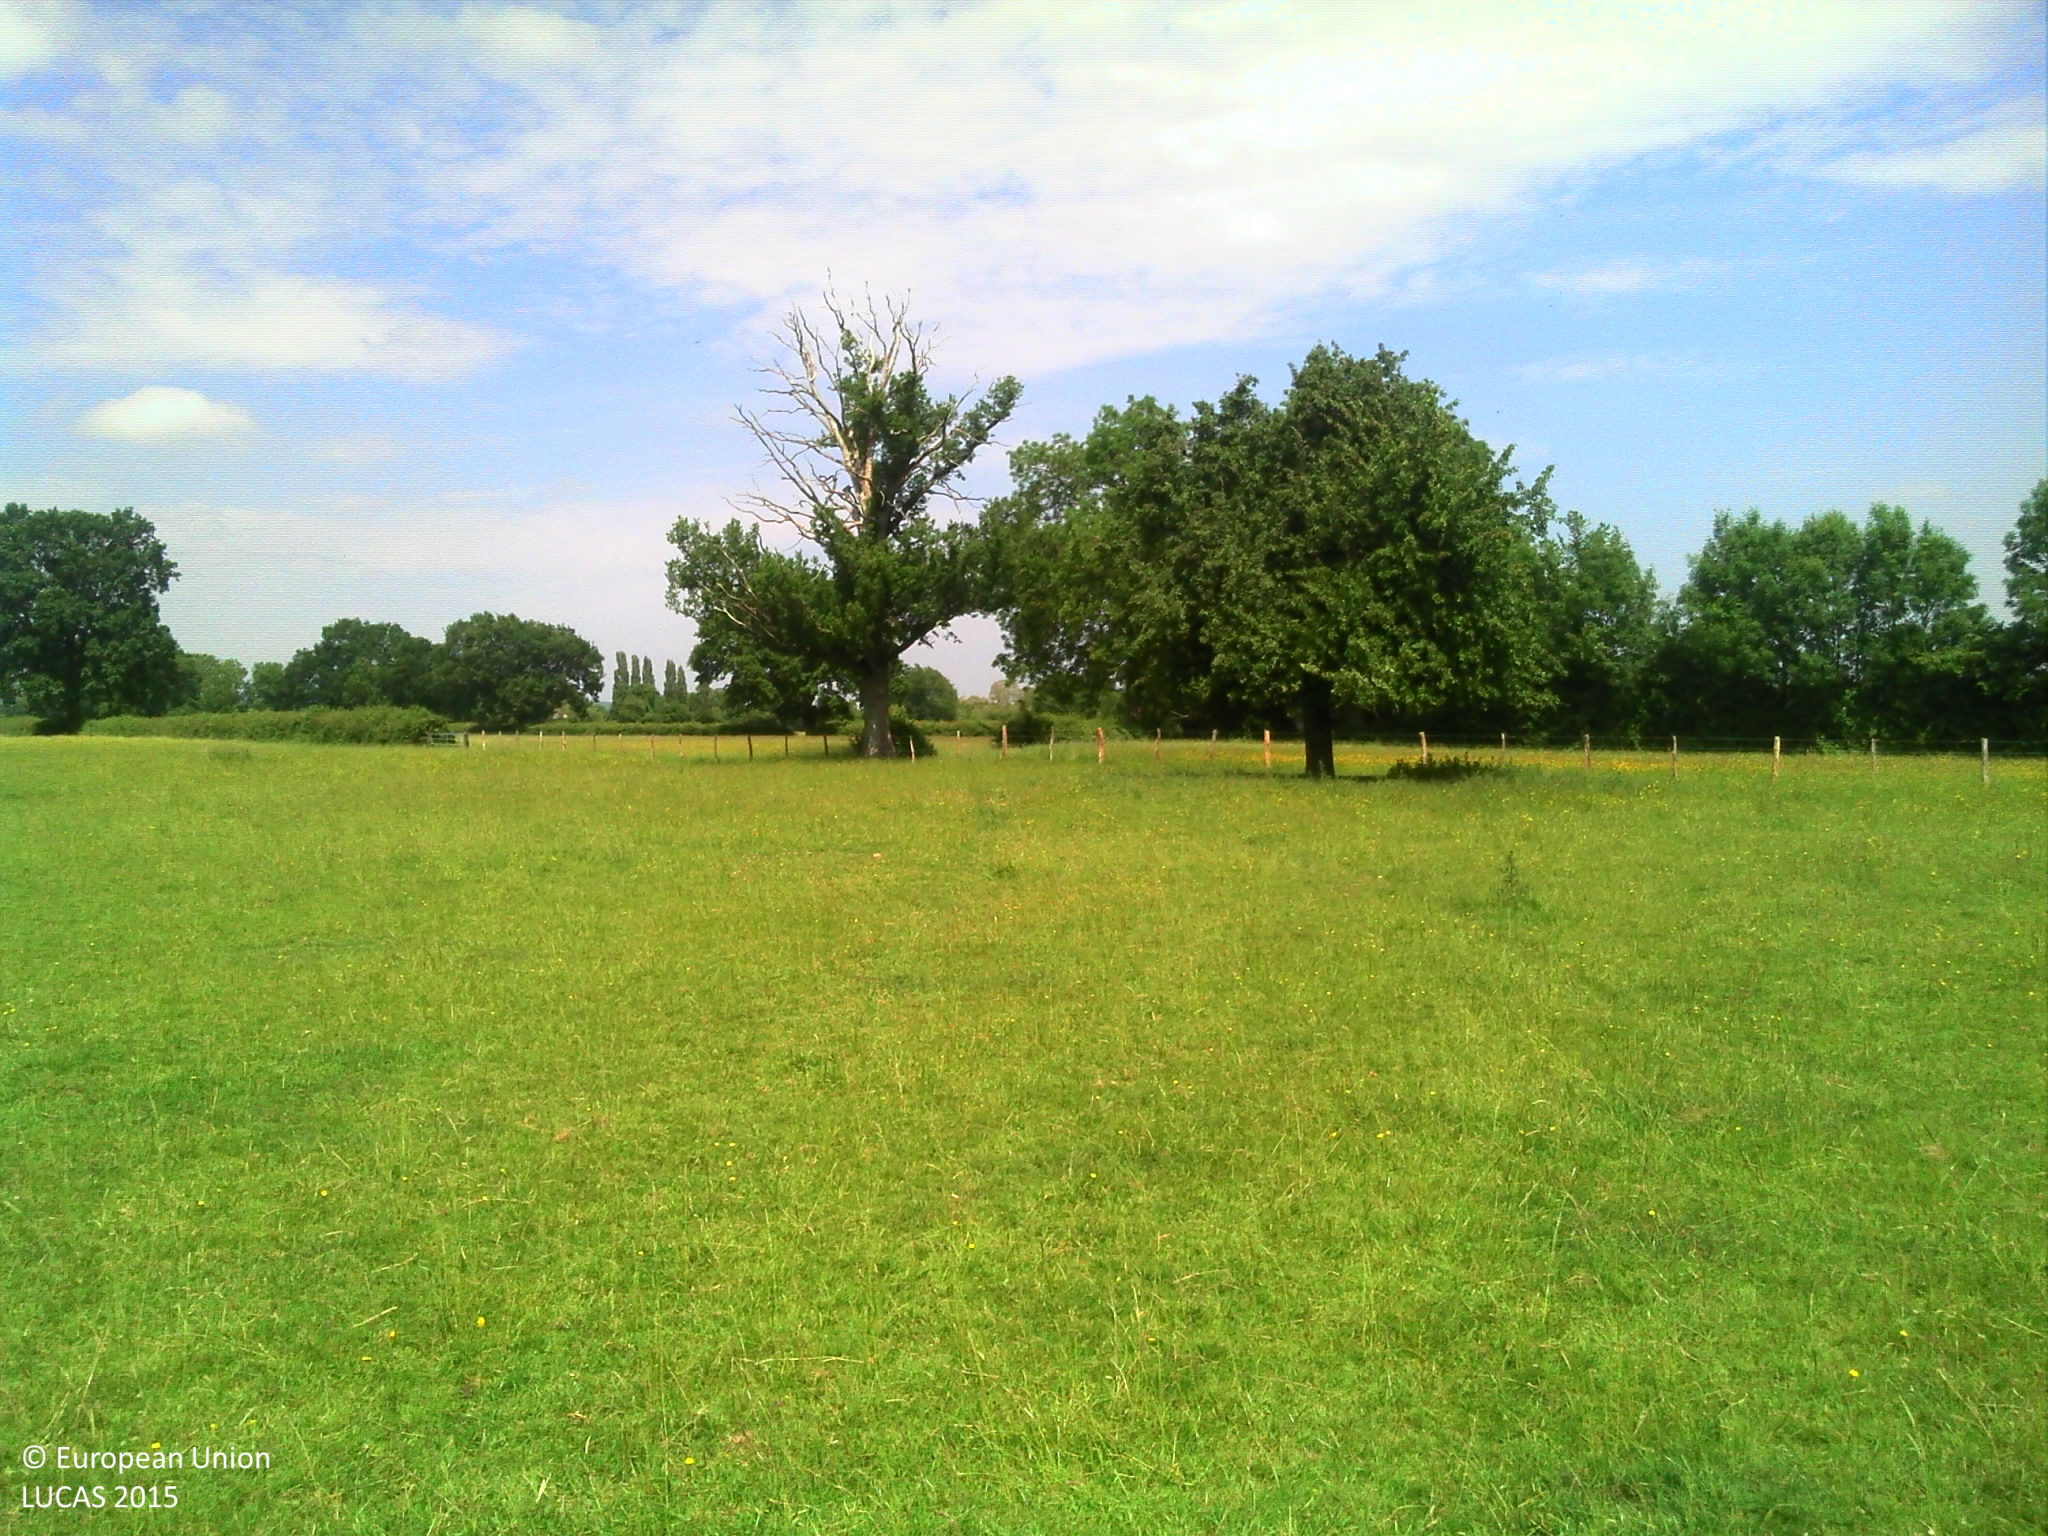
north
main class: Grassland
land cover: Grassland without tree/shrub cover
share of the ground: > 75 %
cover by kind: herbaceous plants 95 %
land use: Agriculture (excluding fallow land and kitchen gardens)
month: June
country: FR
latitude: 48.5096
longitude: 0.1855
